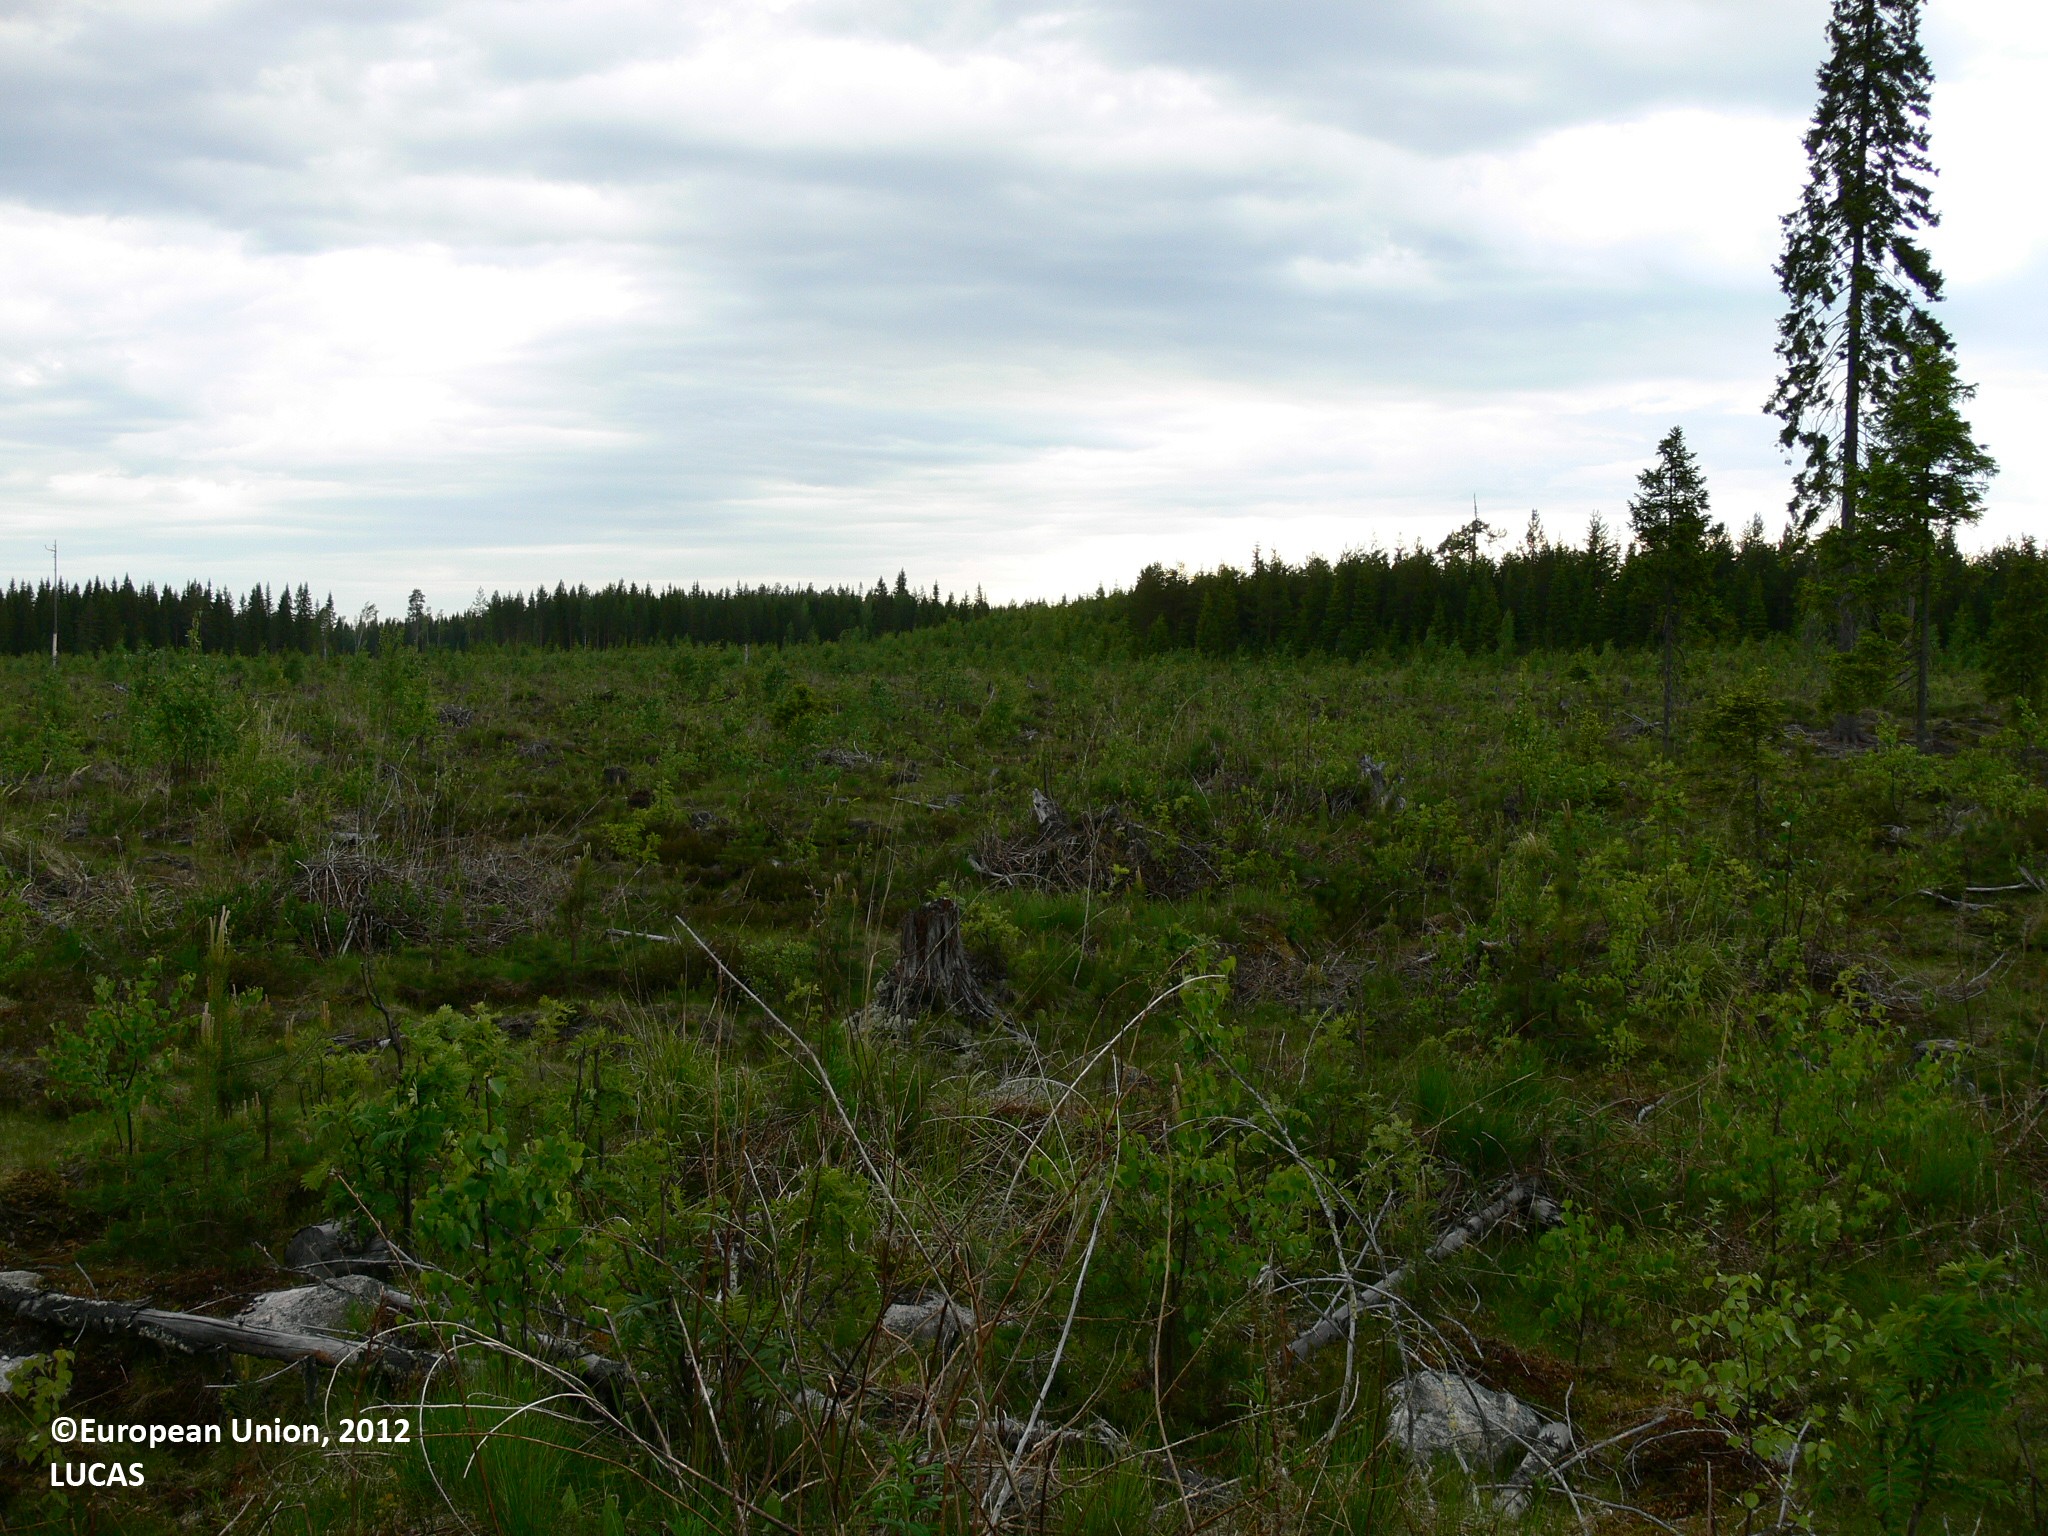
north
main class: Woodland
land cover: Other mixed woodland
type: boreal forest
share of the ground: 25 - 50 %
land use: Forestry
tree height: < 5 m
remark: Clear cut
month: June
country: FI
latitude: 62.6415
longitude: 30.3444
